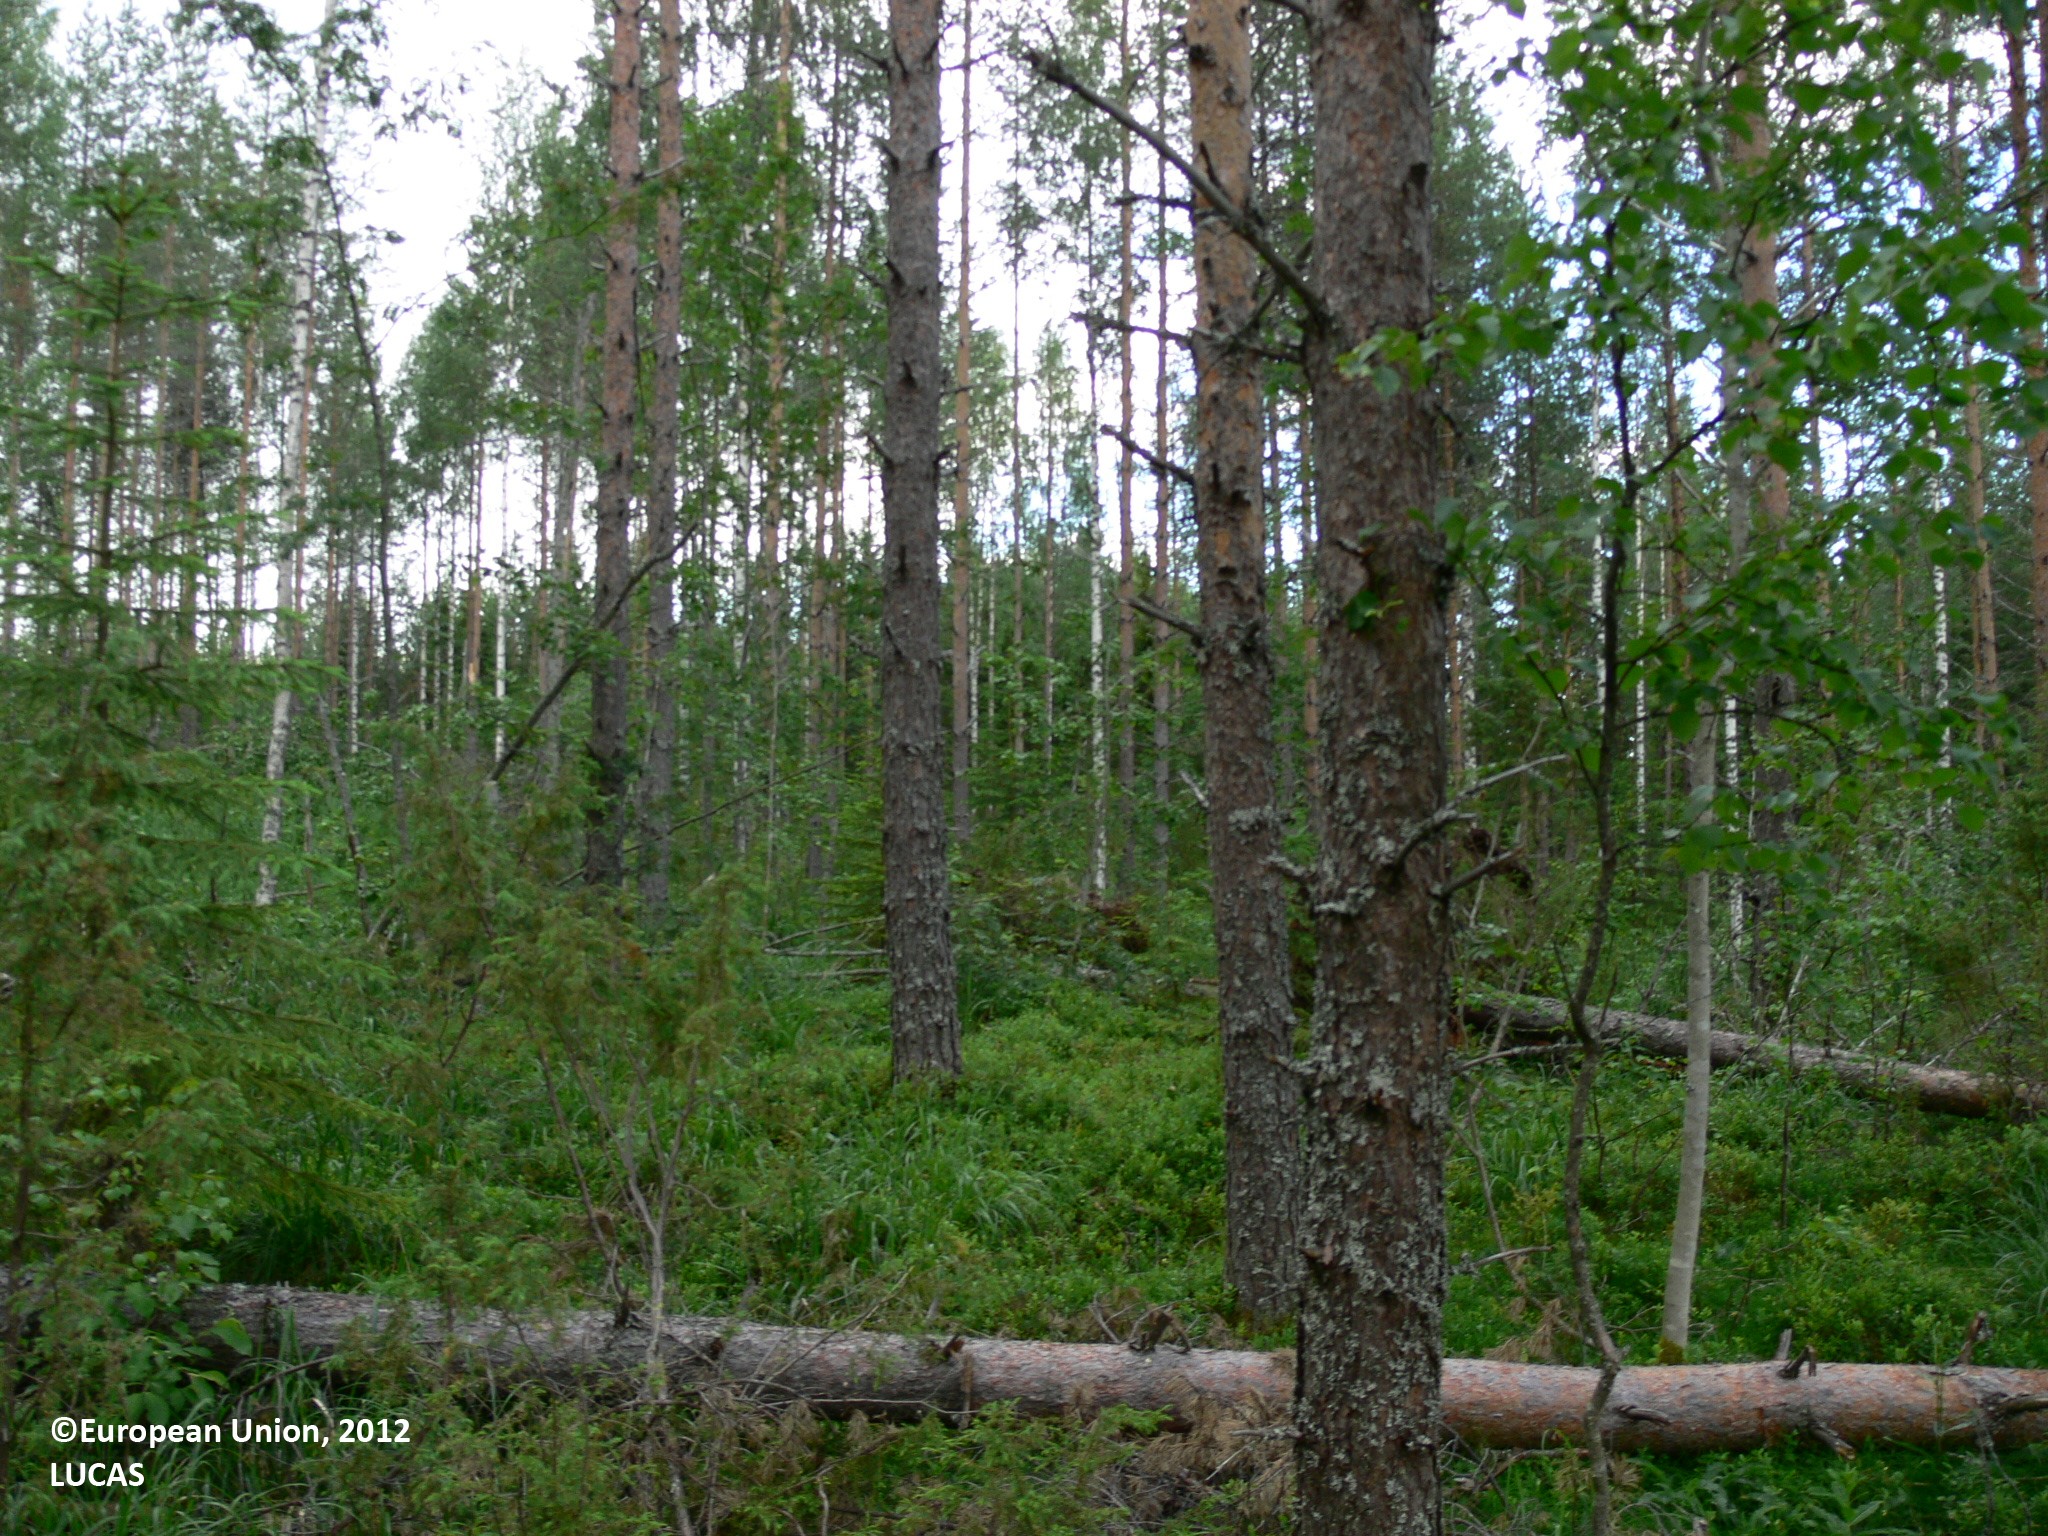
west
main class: Woodland
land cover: Pine dominated coniferous woodland
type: boreal forest
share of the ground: 50 - 75 %
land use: Forestry
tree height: > 5 m
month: July
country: FI
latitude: 62.8880
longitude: 30.5997
